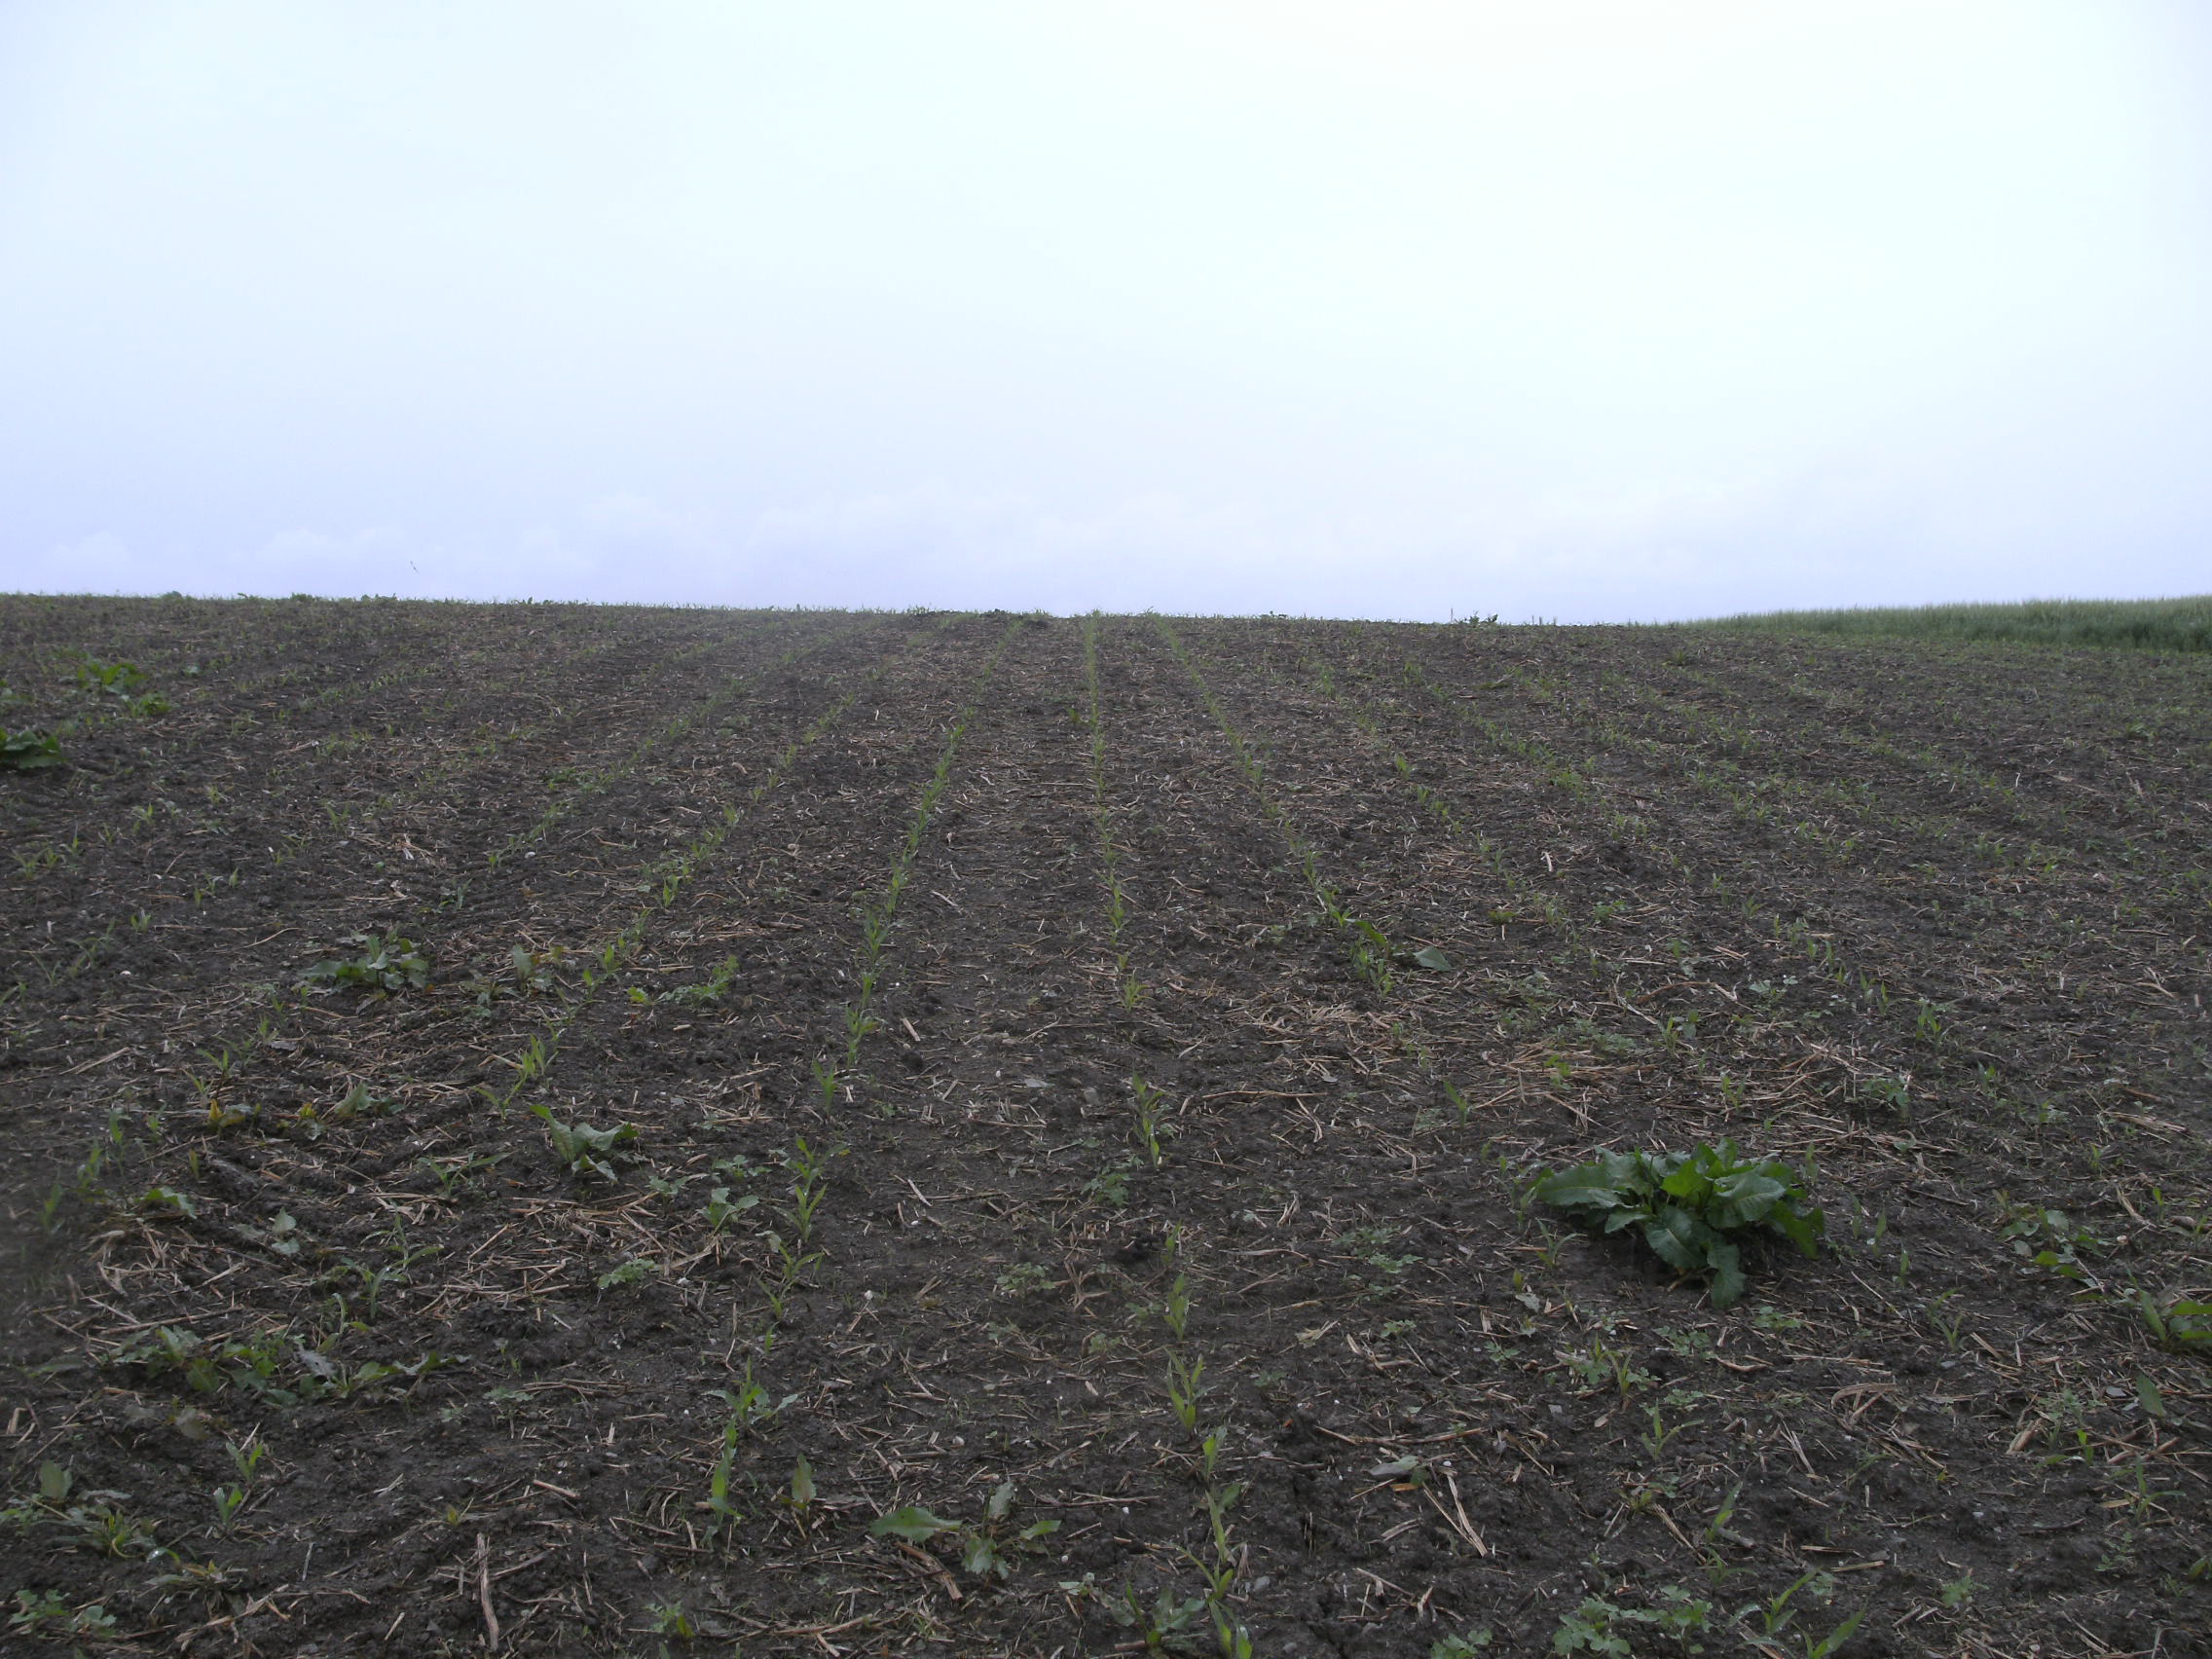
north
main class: Cropland
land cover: Maize
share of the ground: < 10 %
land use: Agriculture (excluding fallow land and kitchen gardens)
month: May
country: AT
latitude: 48.3295
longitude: 13.5199
